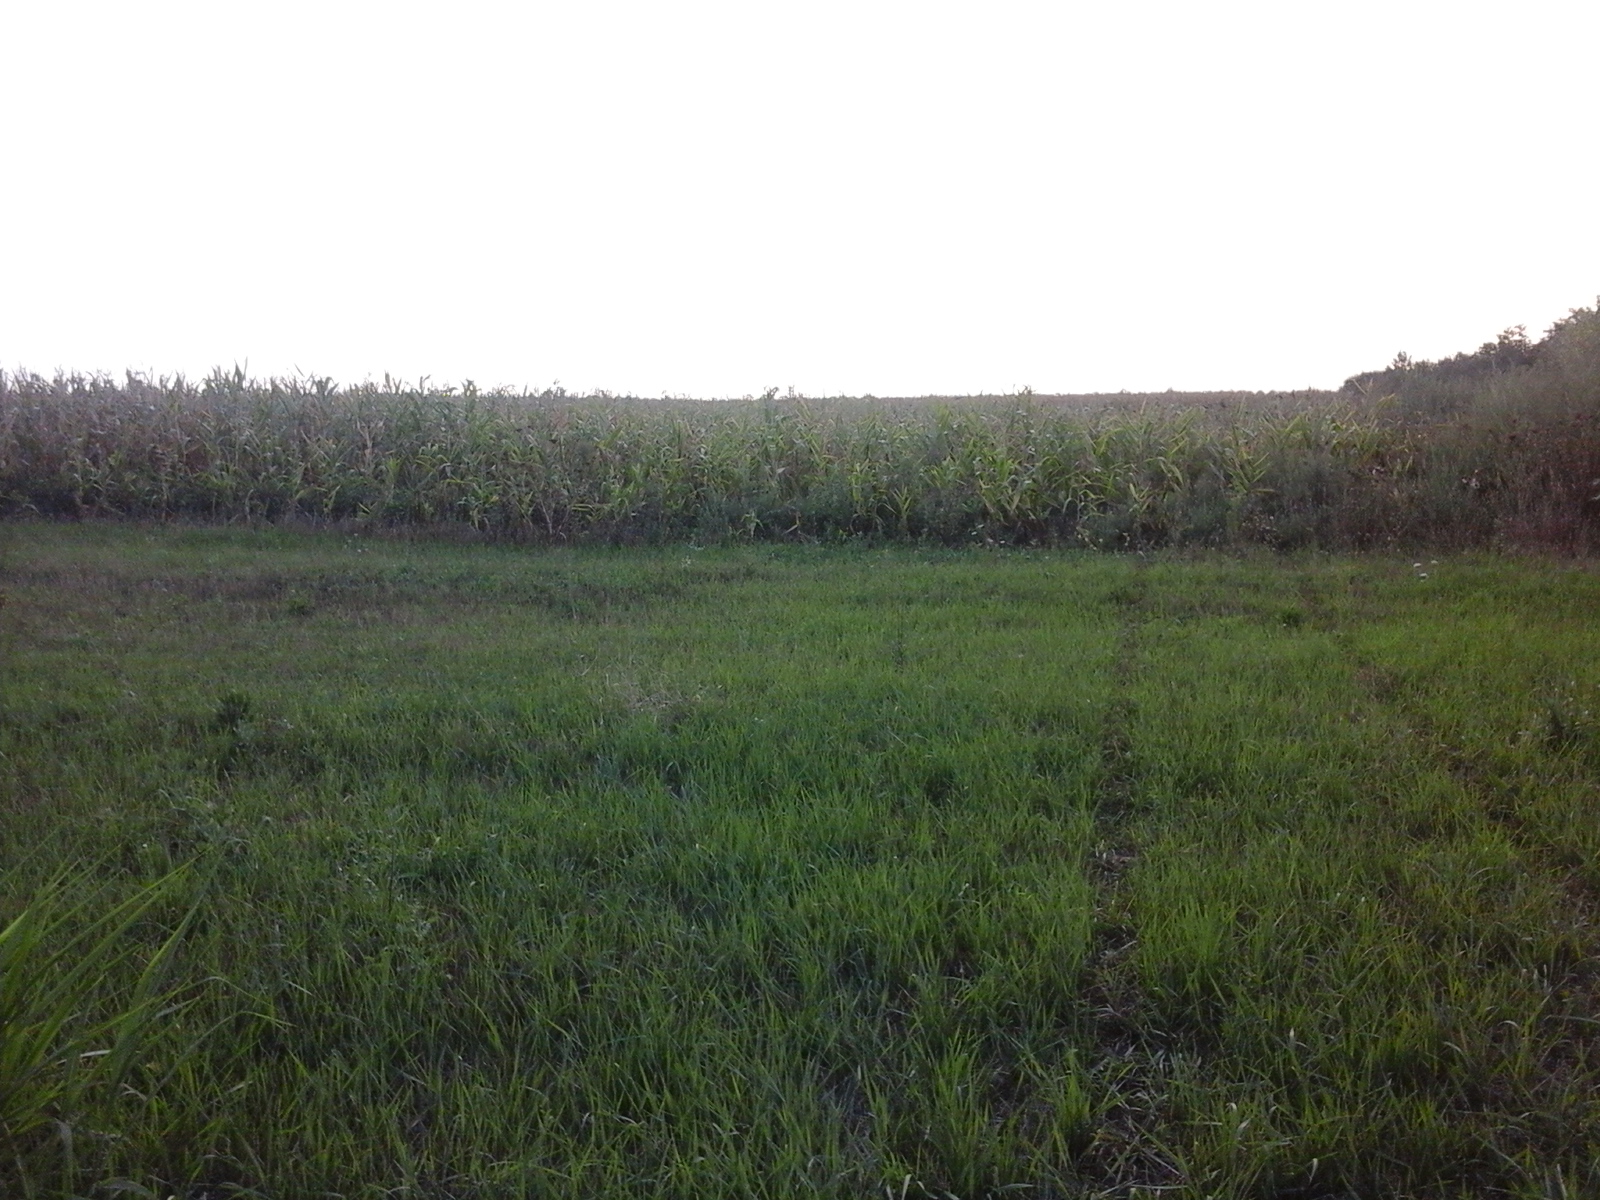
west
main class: Grassland
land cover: Spontaneously vegetated surfaces
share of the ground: > 75 %
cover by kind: herbaceous plants 100 %
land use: Agriculture (excluding fallow land and kitchen gardens)
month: August
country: RO
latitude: 46.4449
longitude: 21.7693
